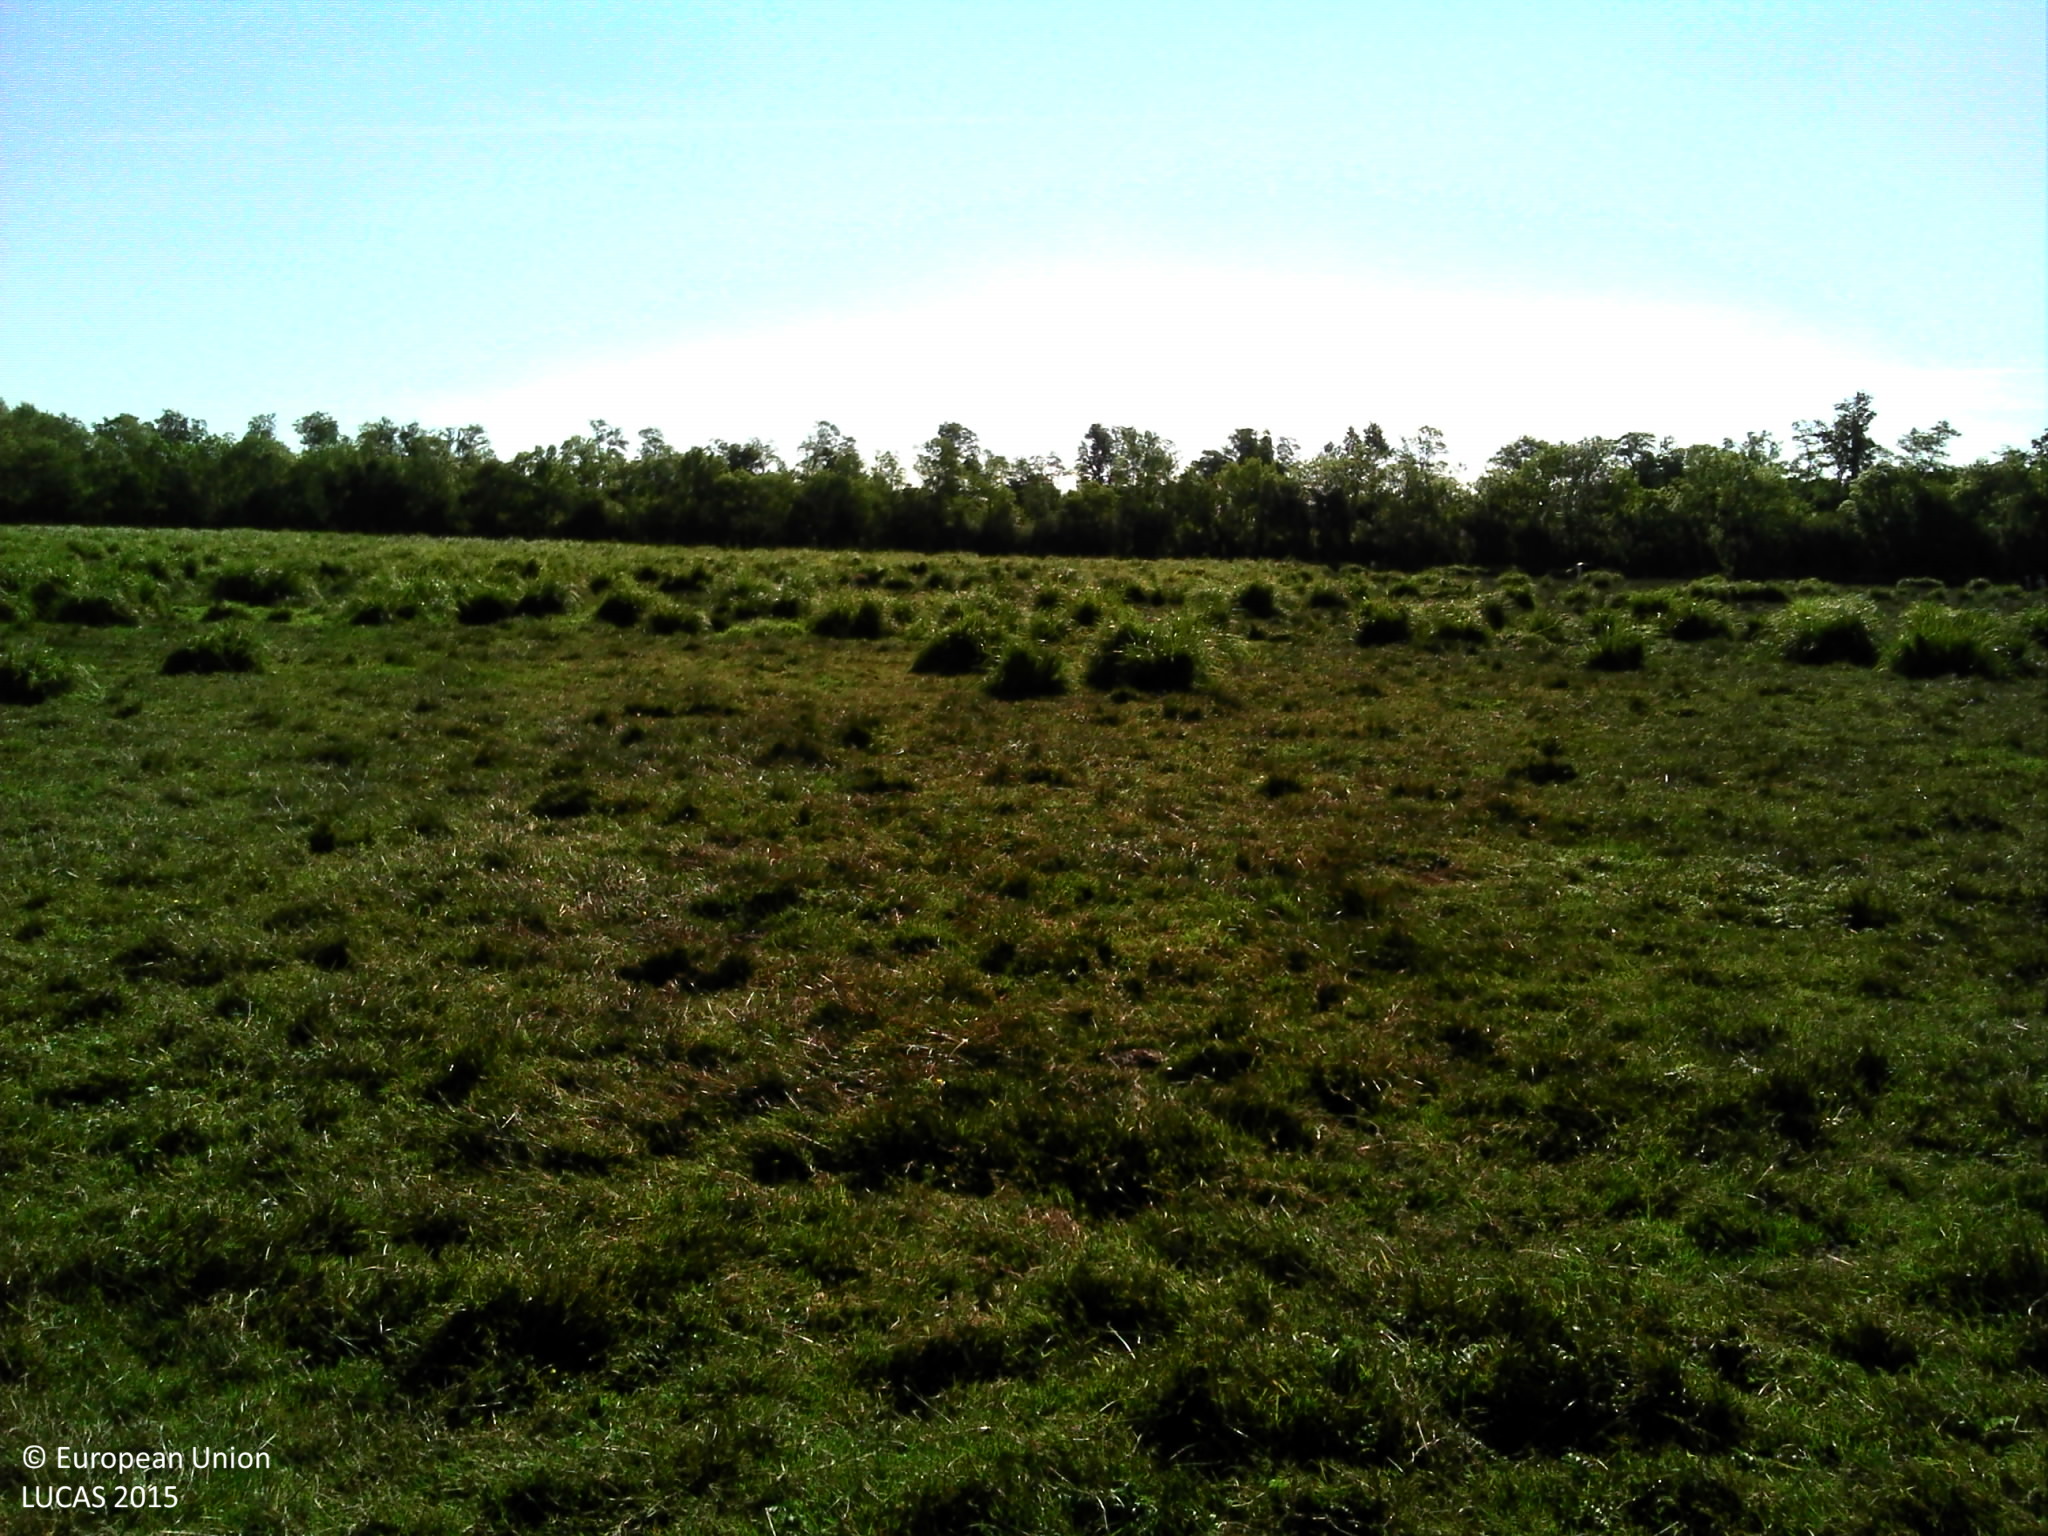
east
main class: Grassland
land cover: Grassland without tree/shrub cover
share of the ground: > 75 %
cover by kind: herbaceous plants 100 %
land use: Agriculture (excluding fallow land and kitchen gardens)
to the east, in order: Grassland without tree/shrub cover; Fences; Broadleaved woodland; Railways; Tracks; Broadleaved woodland; Spontaneously vegetated surfaces; Fences; Grassland without tree/shrub cover
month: July
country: FR
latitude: 47.4090
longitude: -2.0969
